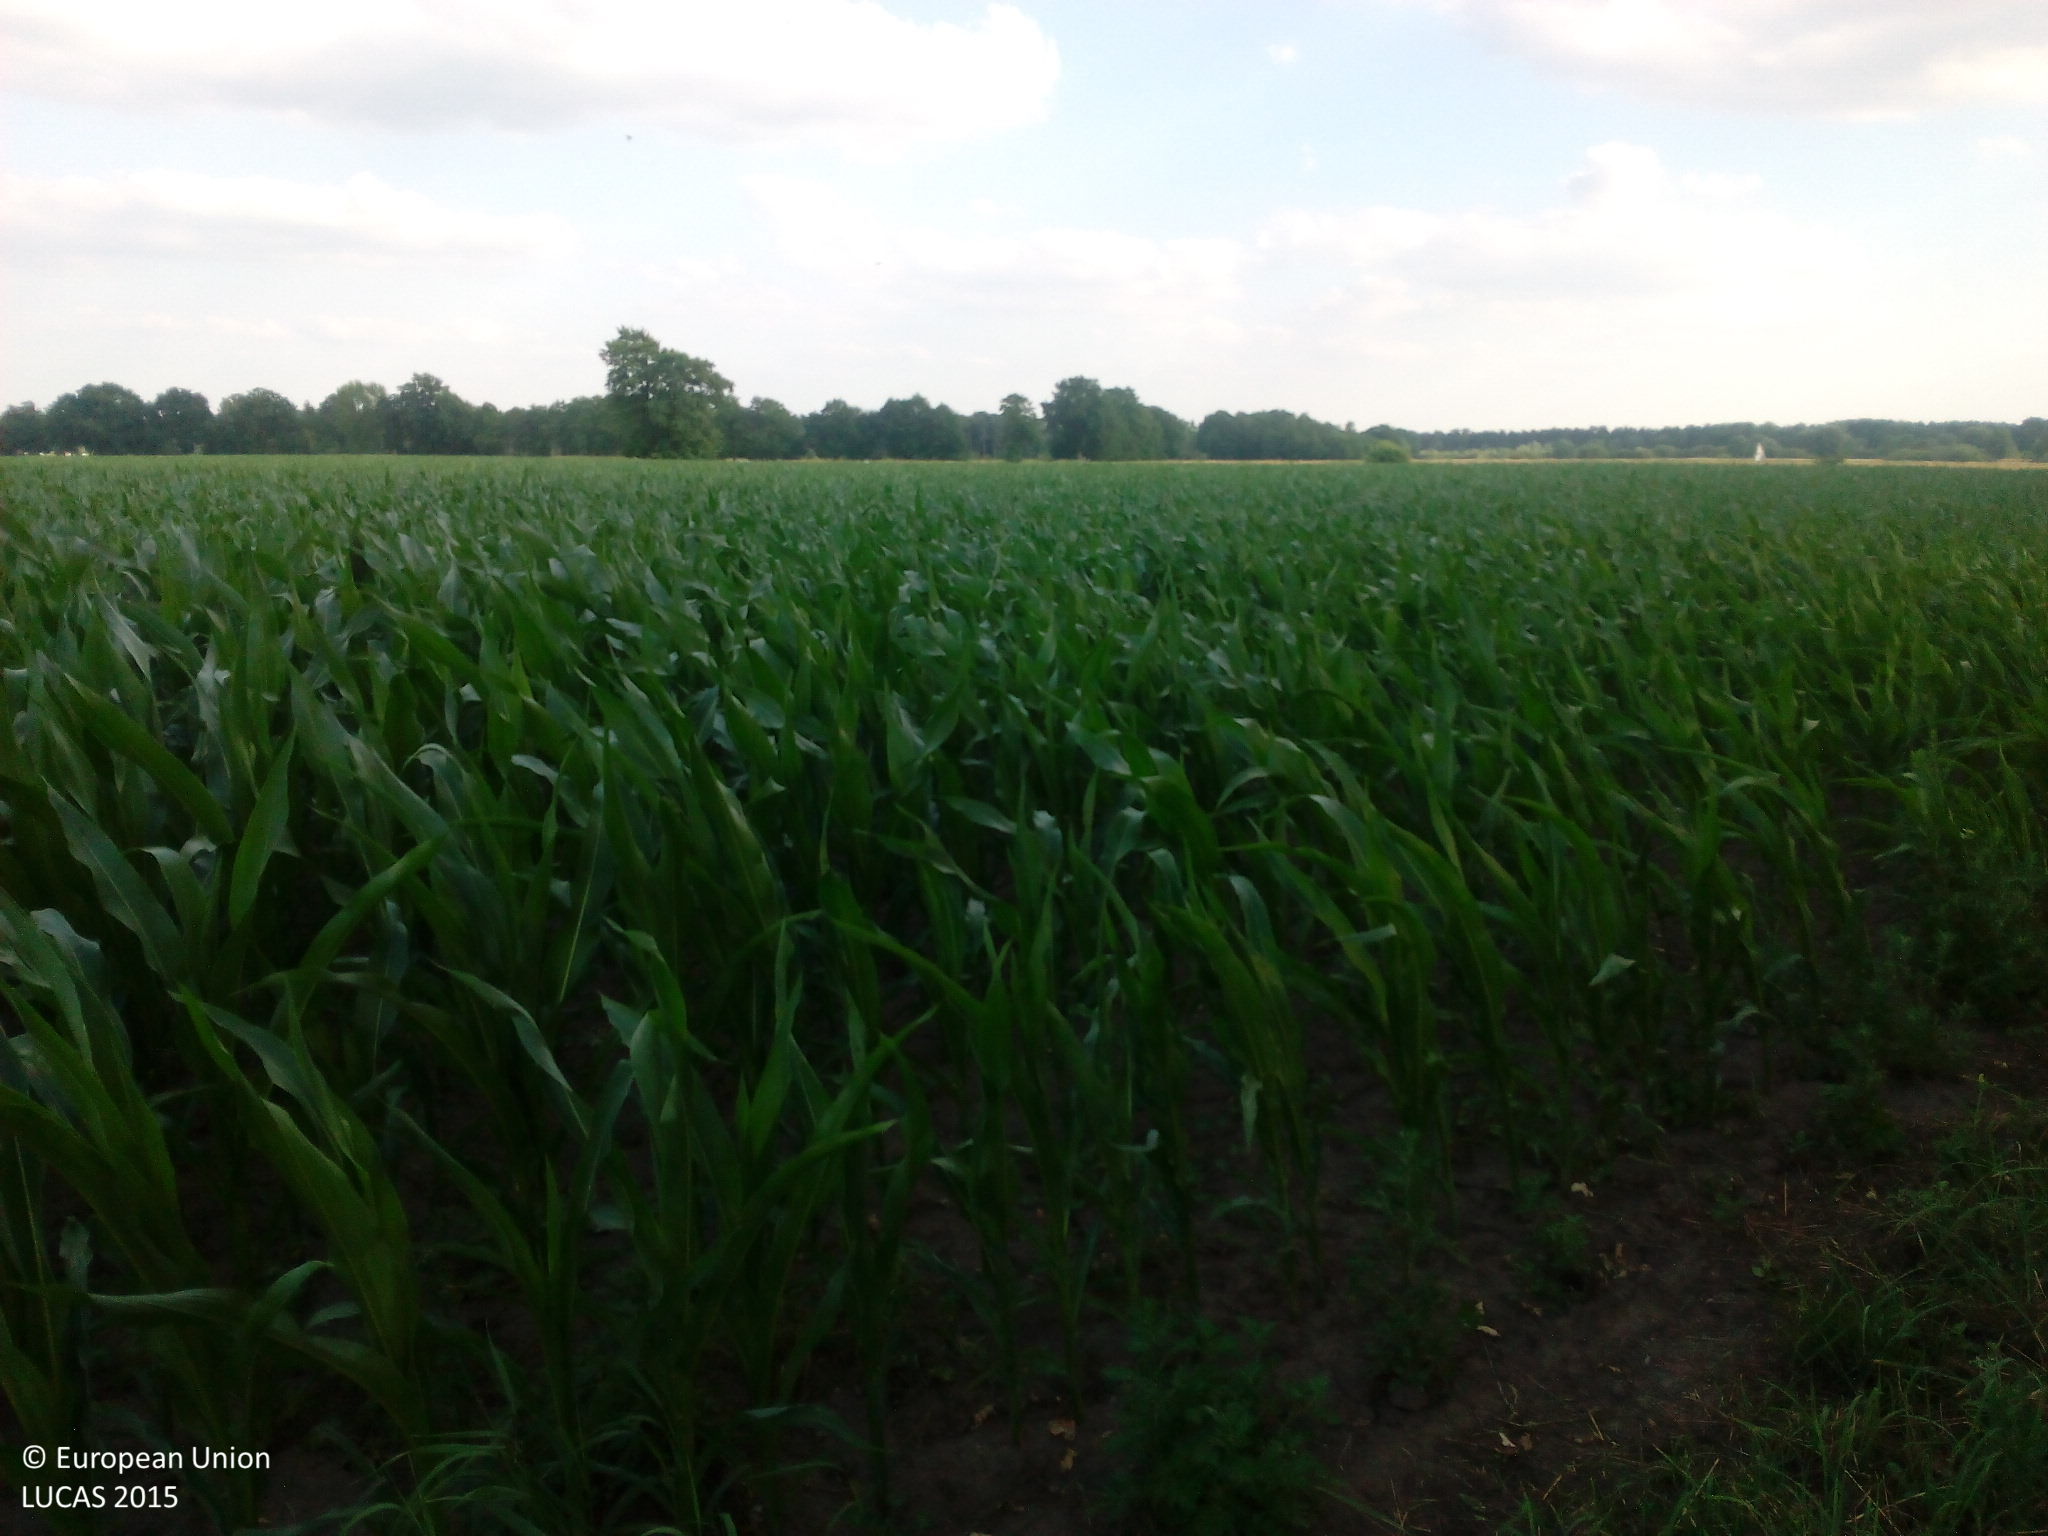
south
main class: Cropland
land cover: Maize
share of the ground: > 75 %
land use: Agriculture (excluding fallow land and kitchen gardens)
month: July
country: DE
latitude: 52.6557
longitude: 7.4429
